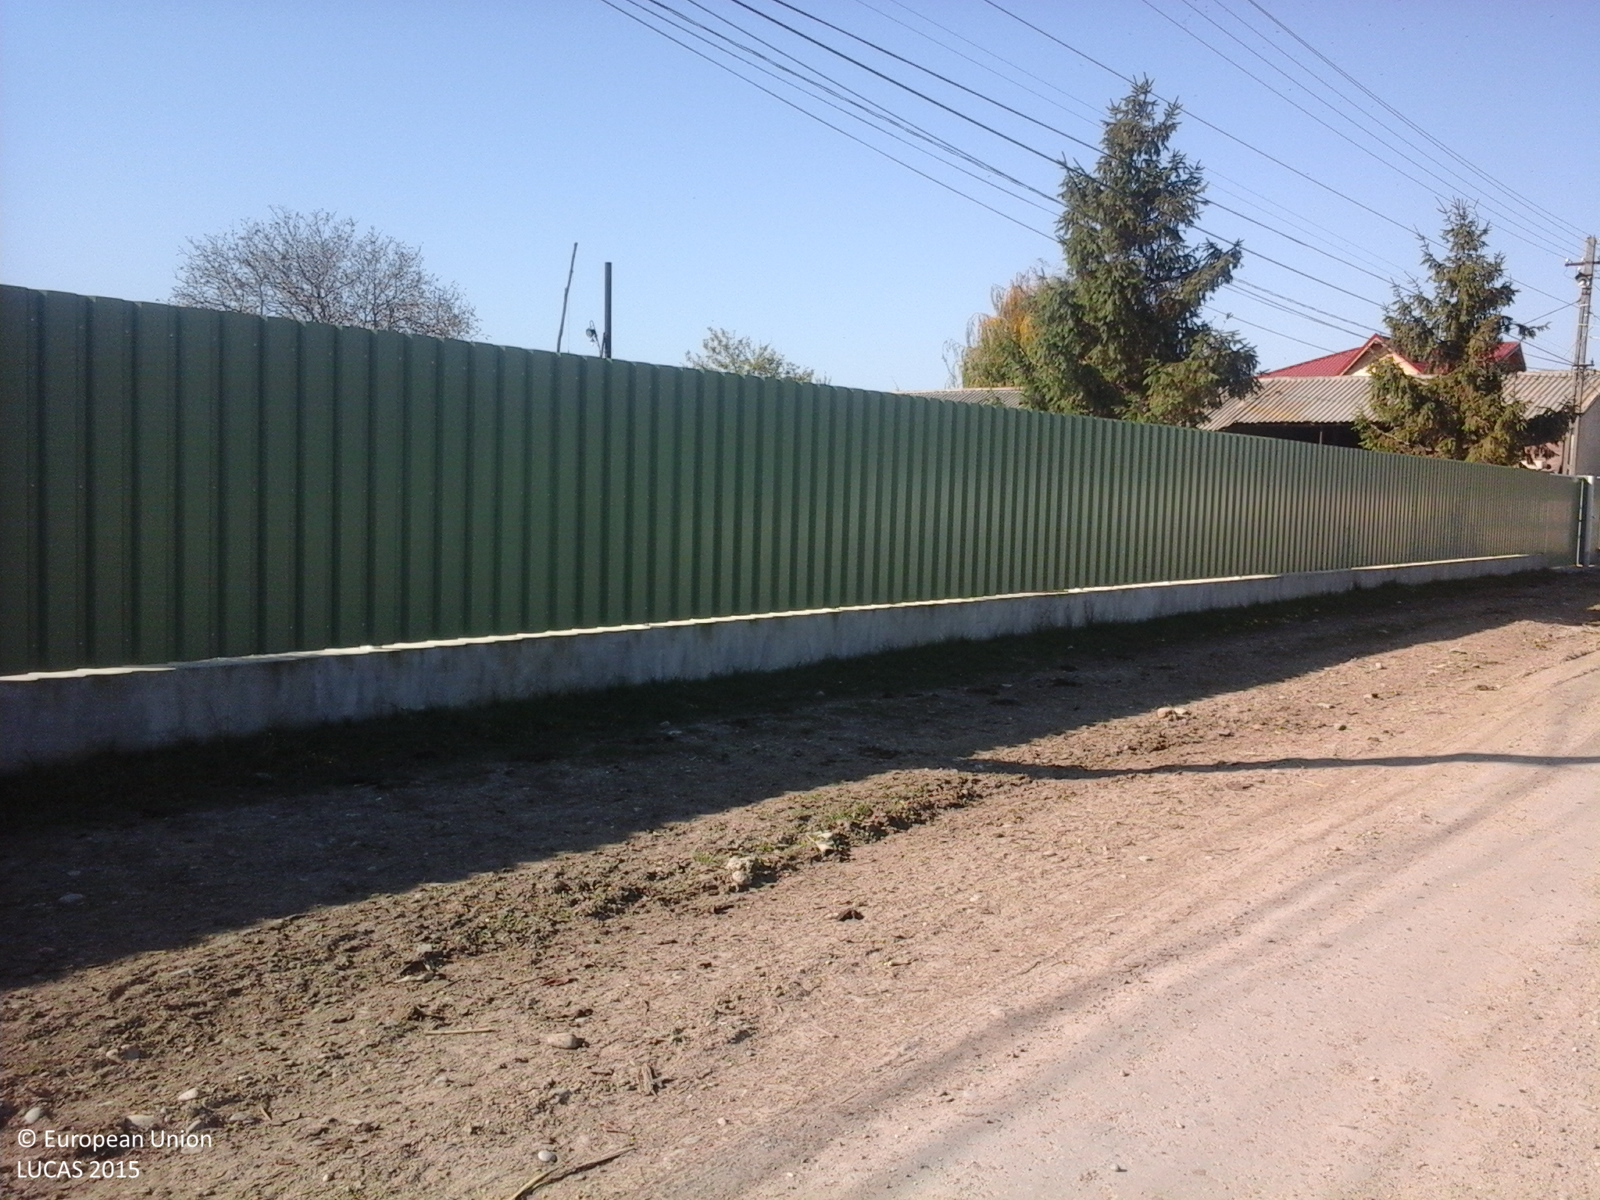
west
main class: Cropland
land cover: Maize
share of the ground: 25 - 50 %
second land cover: Spontaneously vegetated surfaces
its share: 25 - 50 %
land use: Kitchen garden
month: October
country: RO
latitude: 45.6673
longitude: 27.3903
